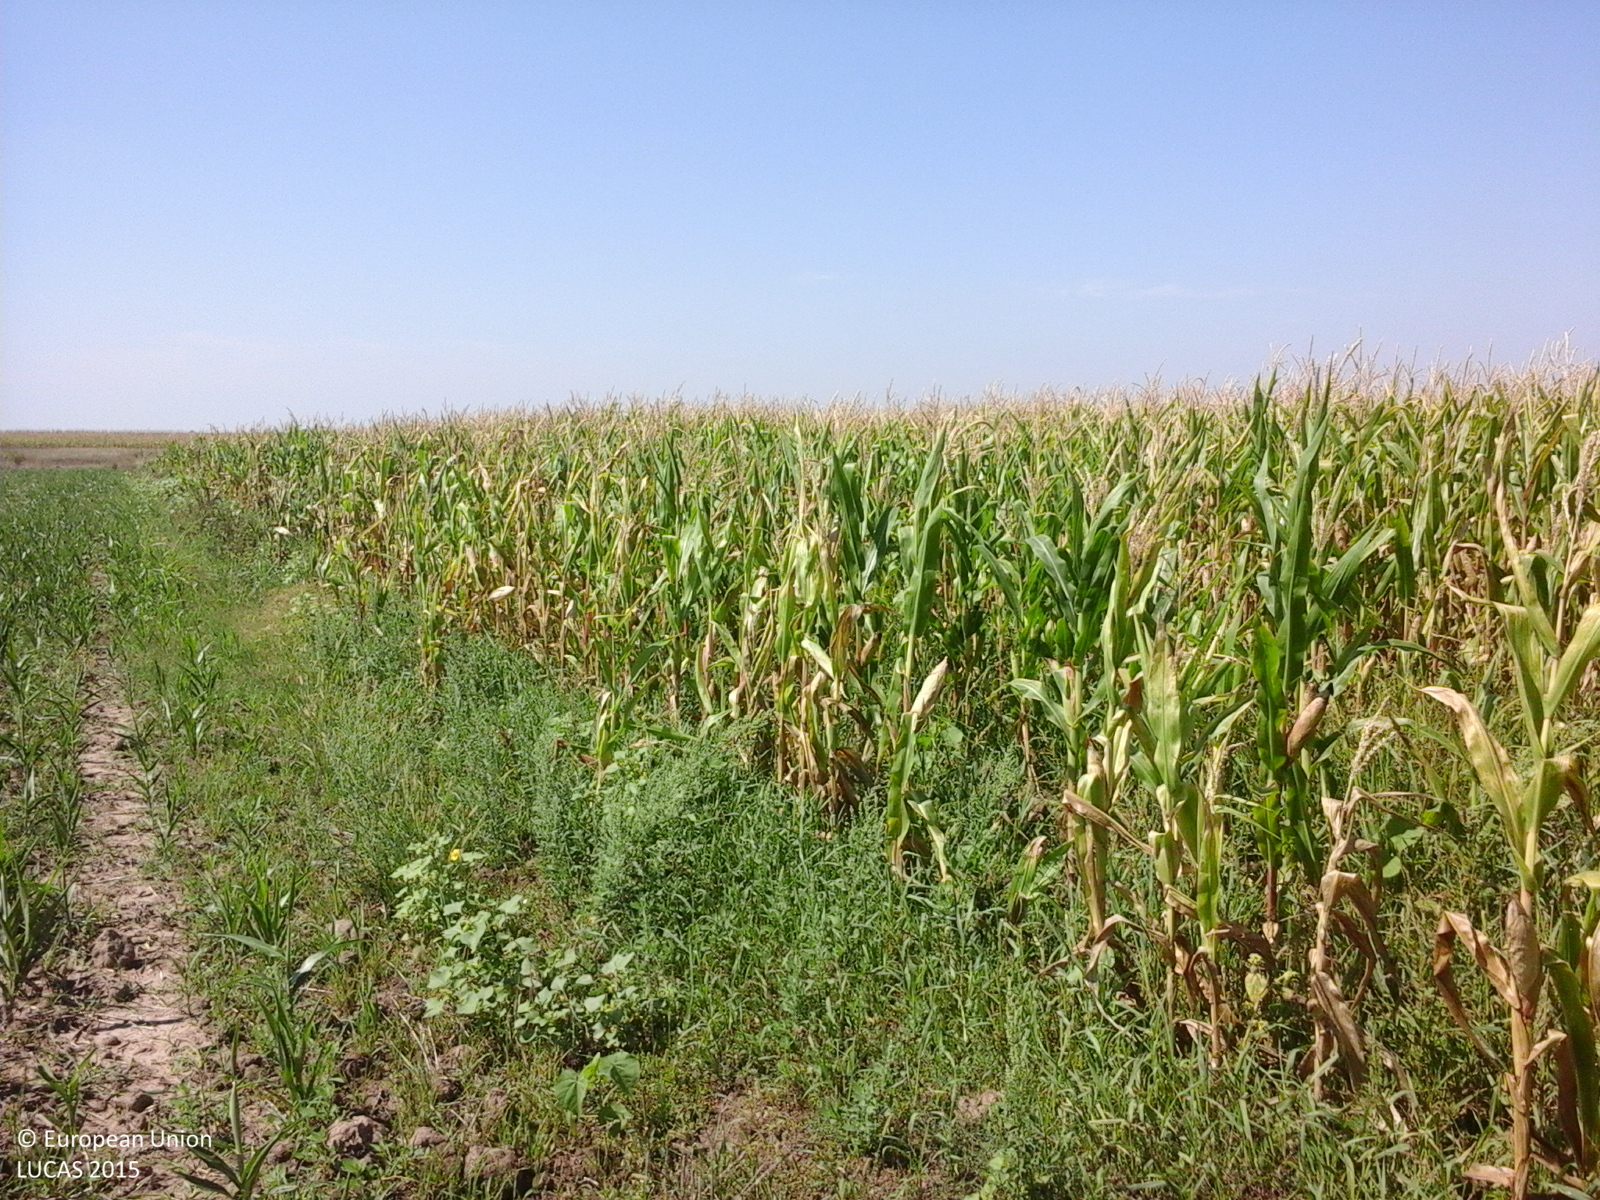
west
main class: Cropland
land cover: Maize
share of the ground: > 75 %
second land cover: Spontaneously vegetated surfaces
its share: > 75 %
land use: Agriculture (excluding fallow land and kitchen gardens)
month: August
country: RO
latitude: 45.6362
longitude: 21.1774
